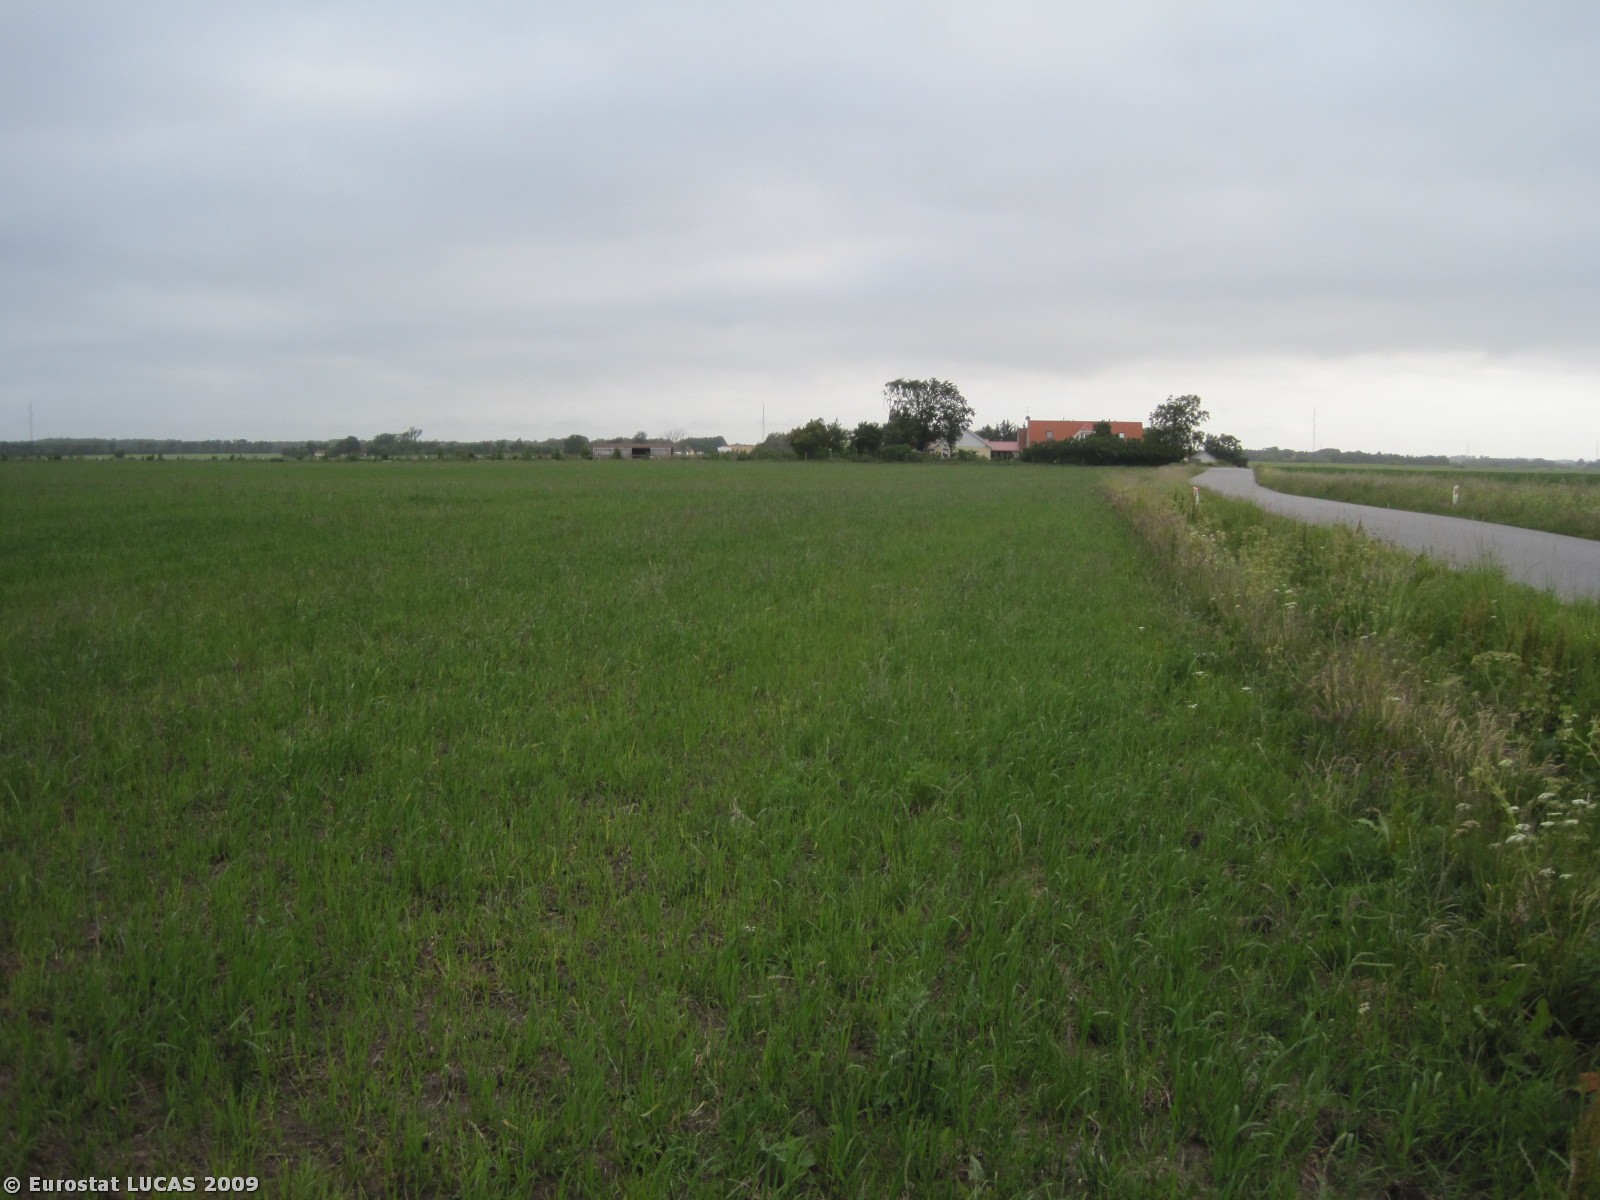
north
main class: Cropland
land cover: Rye
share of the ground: 50 - 75 %
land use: Agriculture (excluding fallow land and kitchen gardens)
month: June
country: DK
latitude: 57.1585
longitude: 10.0495
